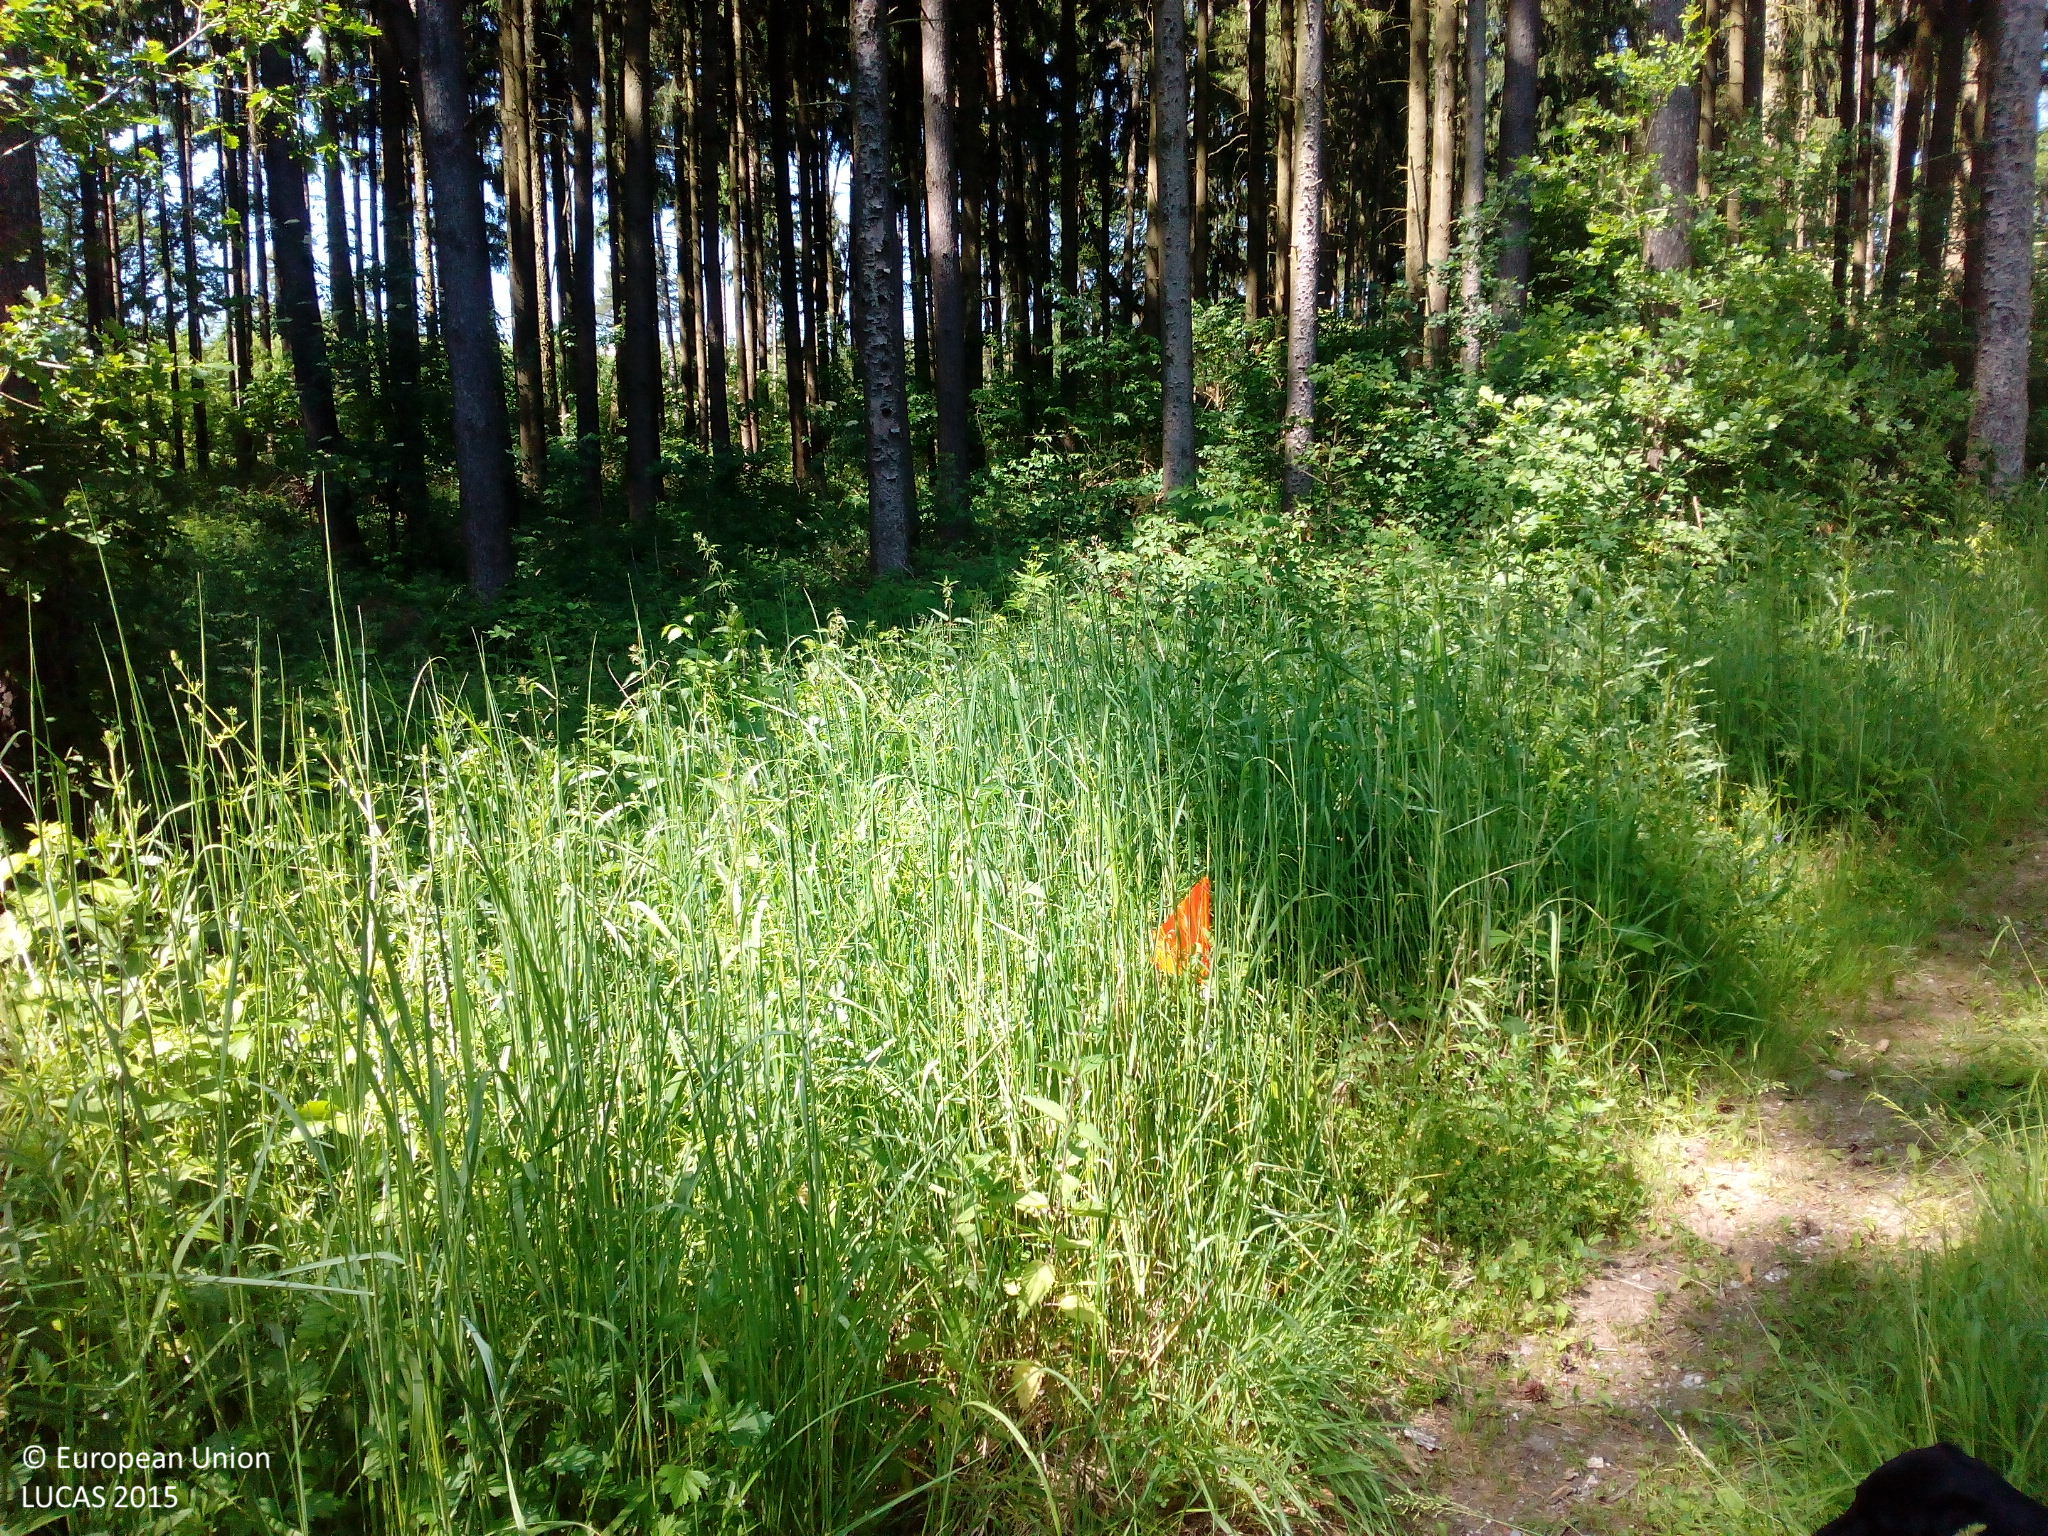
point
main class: Woodland
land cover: Spruce dominated mixed woodland
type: hemiboreal forest and nemoral coniferous forest and mixed broadleaved-coniferous forest
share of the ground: 50 - 75 %
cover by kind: coniferous forest trees 35 %, herbaceous plants 35 %, broadleaved forest trees 20 %, shrubs 10 %
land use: Forestry
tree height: > 5 m
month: June
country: DE
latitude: 48.7913
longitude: 12.4086
